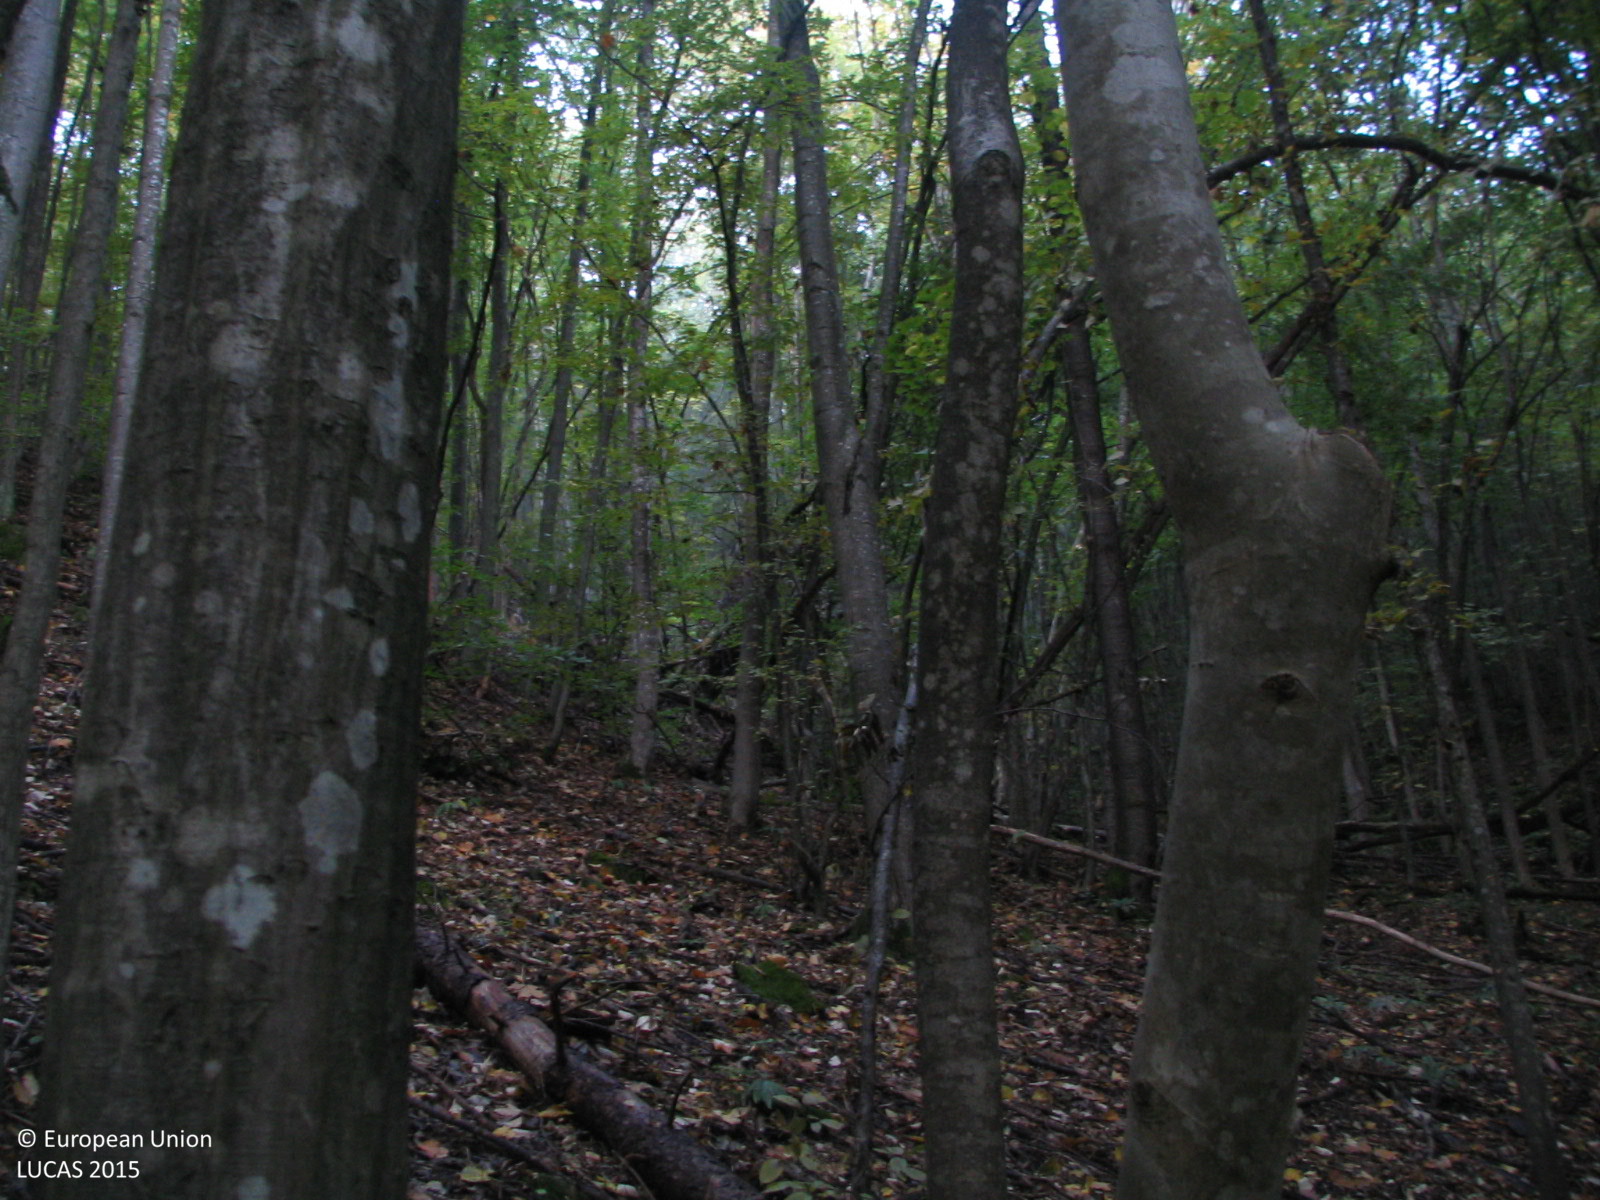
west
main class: Woodland
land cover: Broadleaved woodland
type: beech forest
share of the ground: > 75 %
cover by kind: broadleaved forest trees 100 %
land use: Forestry
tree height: > 5 m
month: October
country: BG
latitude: 42.8539
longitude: 24.0845
